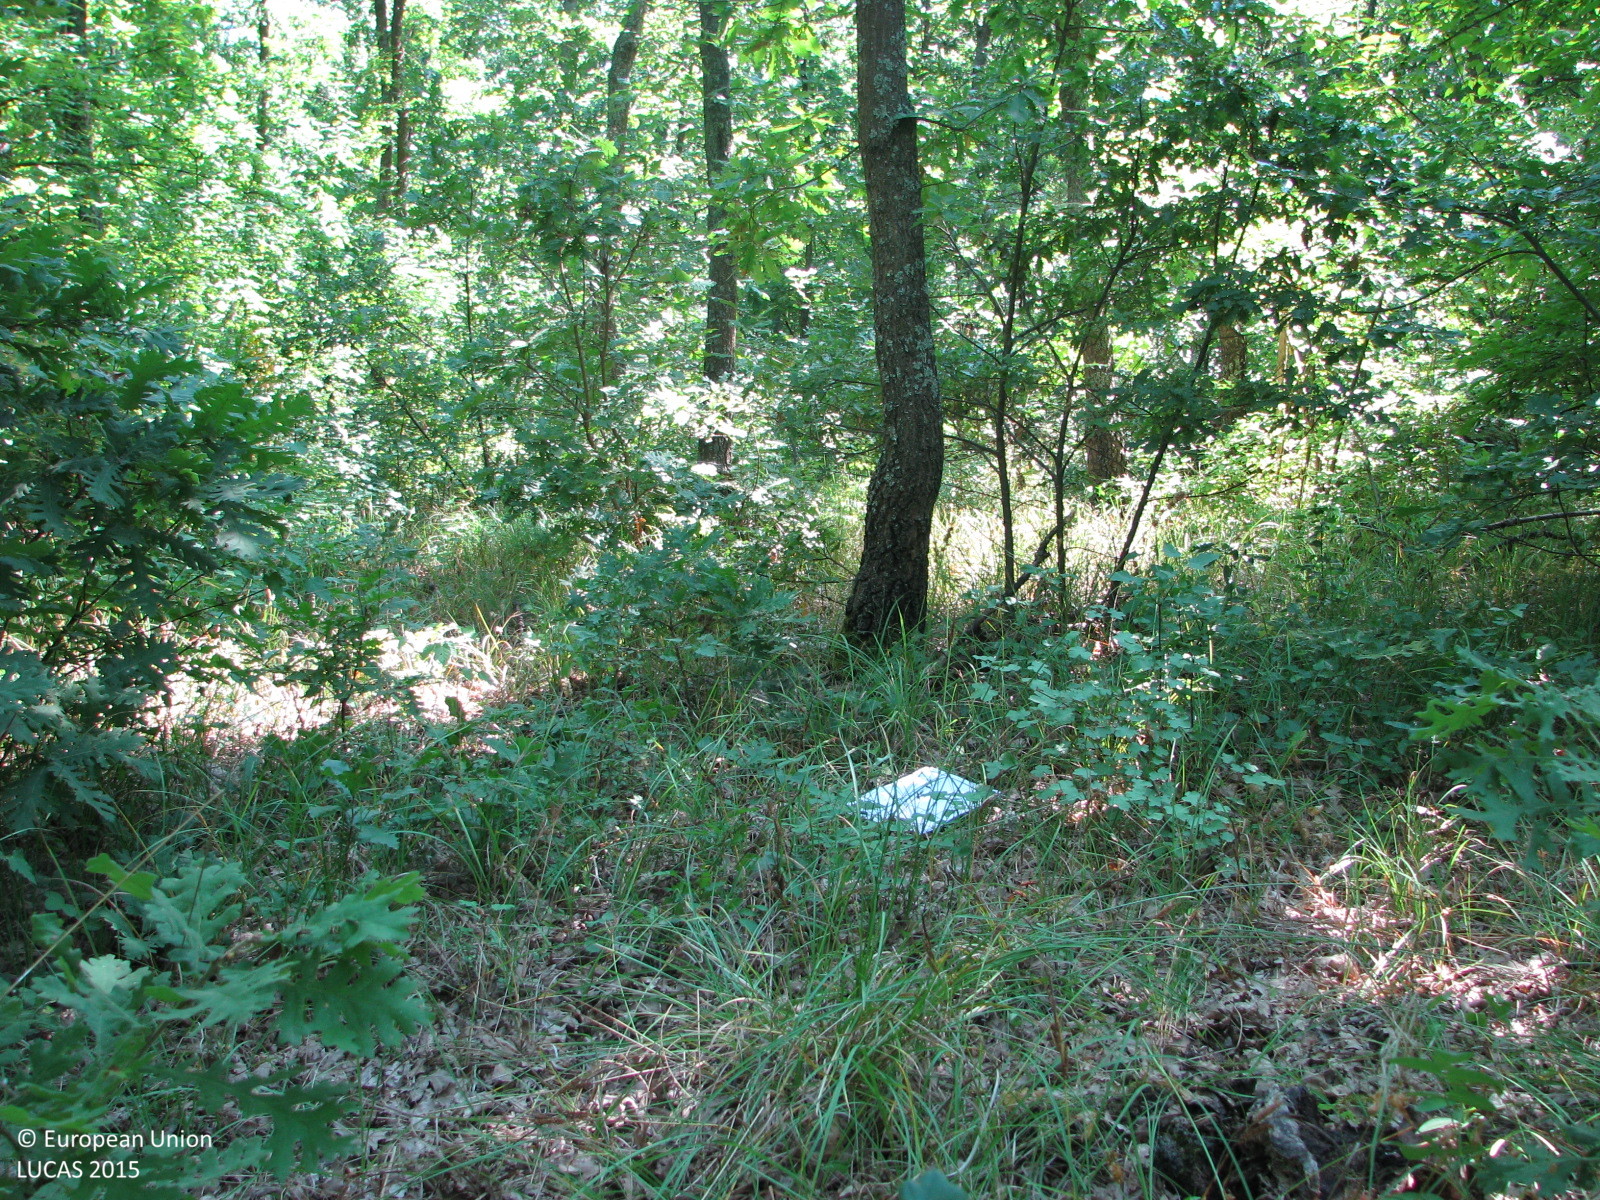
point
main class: Woodland
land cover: Broadleaved woodland
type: thermophilous deciduous forest
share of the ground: 50 - 75 %
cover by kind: broadleaved forest trees 60 %, herbaceous plants 30 %, shrubs 10 %
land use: Forestry
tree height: > 5 m
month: July
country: BG
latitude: 42.2631
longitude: 26.8391
